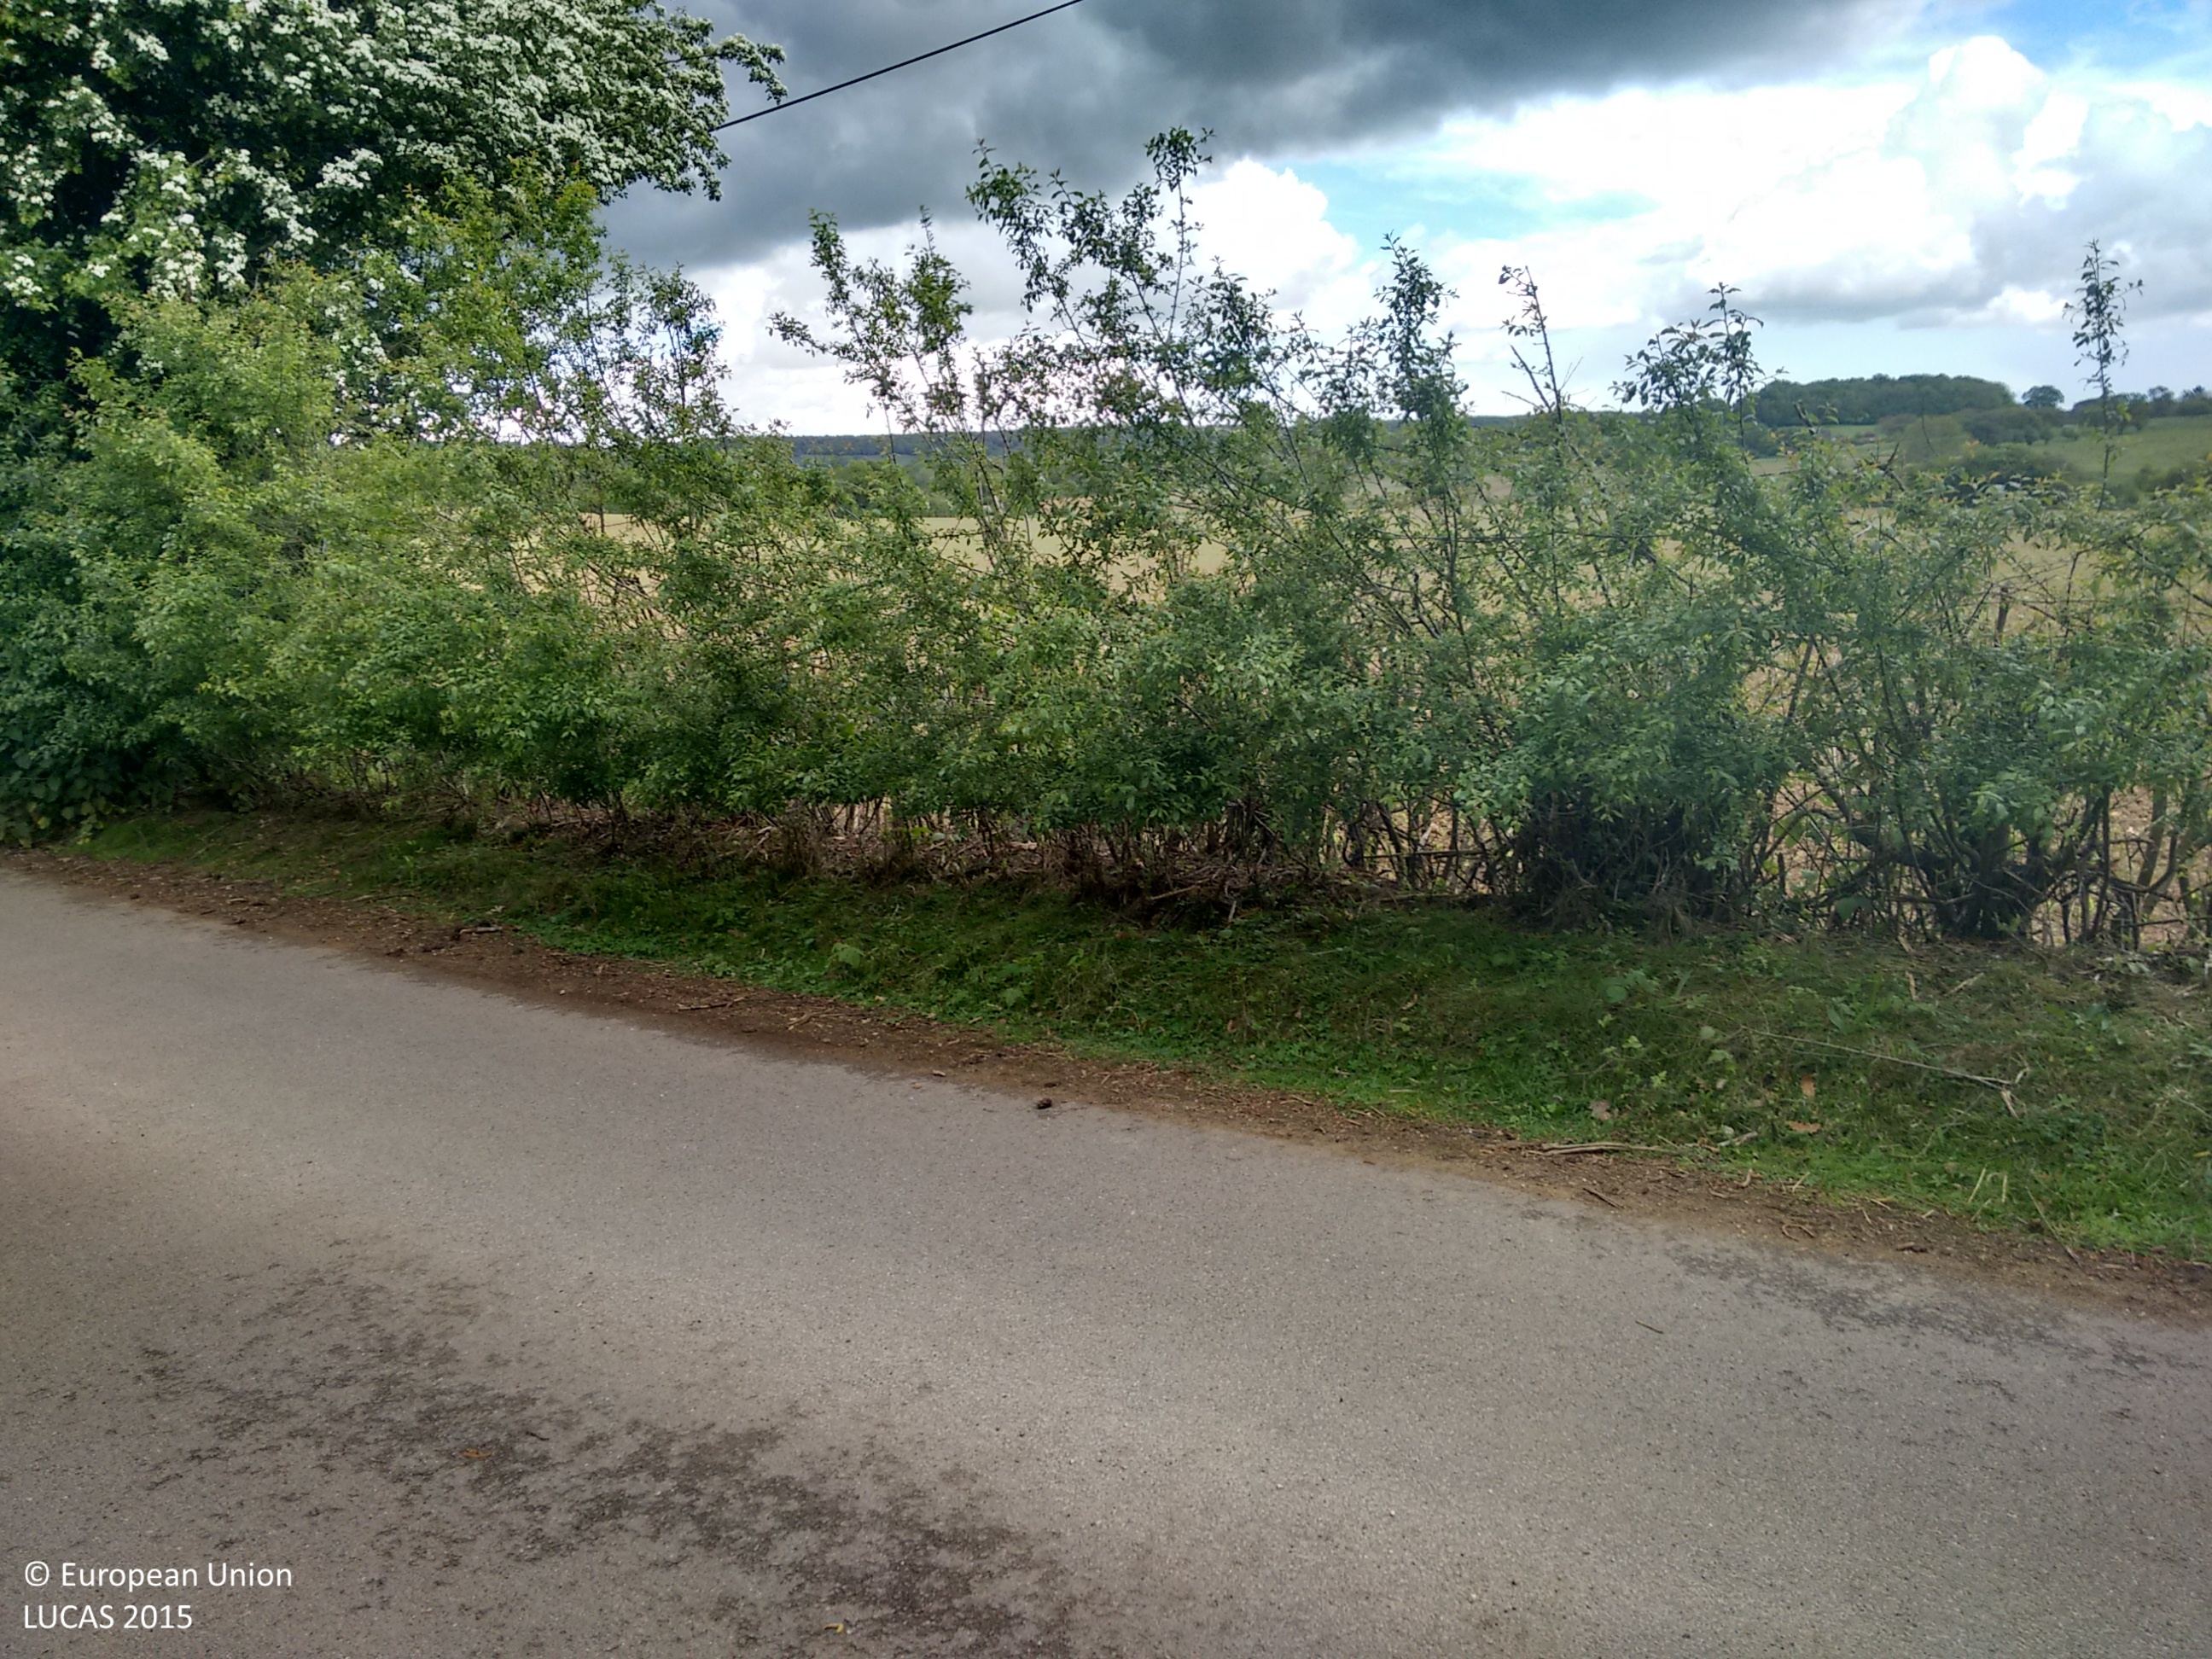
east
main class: Woodland
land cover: Broadleaved woodland
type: mesophytic deciduous forest
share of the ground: > 75 %
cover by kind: broadleaved forest trees 80 %, shrubs 20 %
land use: Semi-natural and natural areas not in use
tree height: > 5 m
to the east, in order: Broadleaved woodland; Shrubland with sparse tree cover; Electric lines; Shrubland with sparse tree cover; Fences; Grass margins; Paved roads, cycling and walking lanes; Grass margins; Managed hedges; Fences; Electric lines; Maize
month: May
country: GB
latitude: 51.2030
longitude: 0.7717
